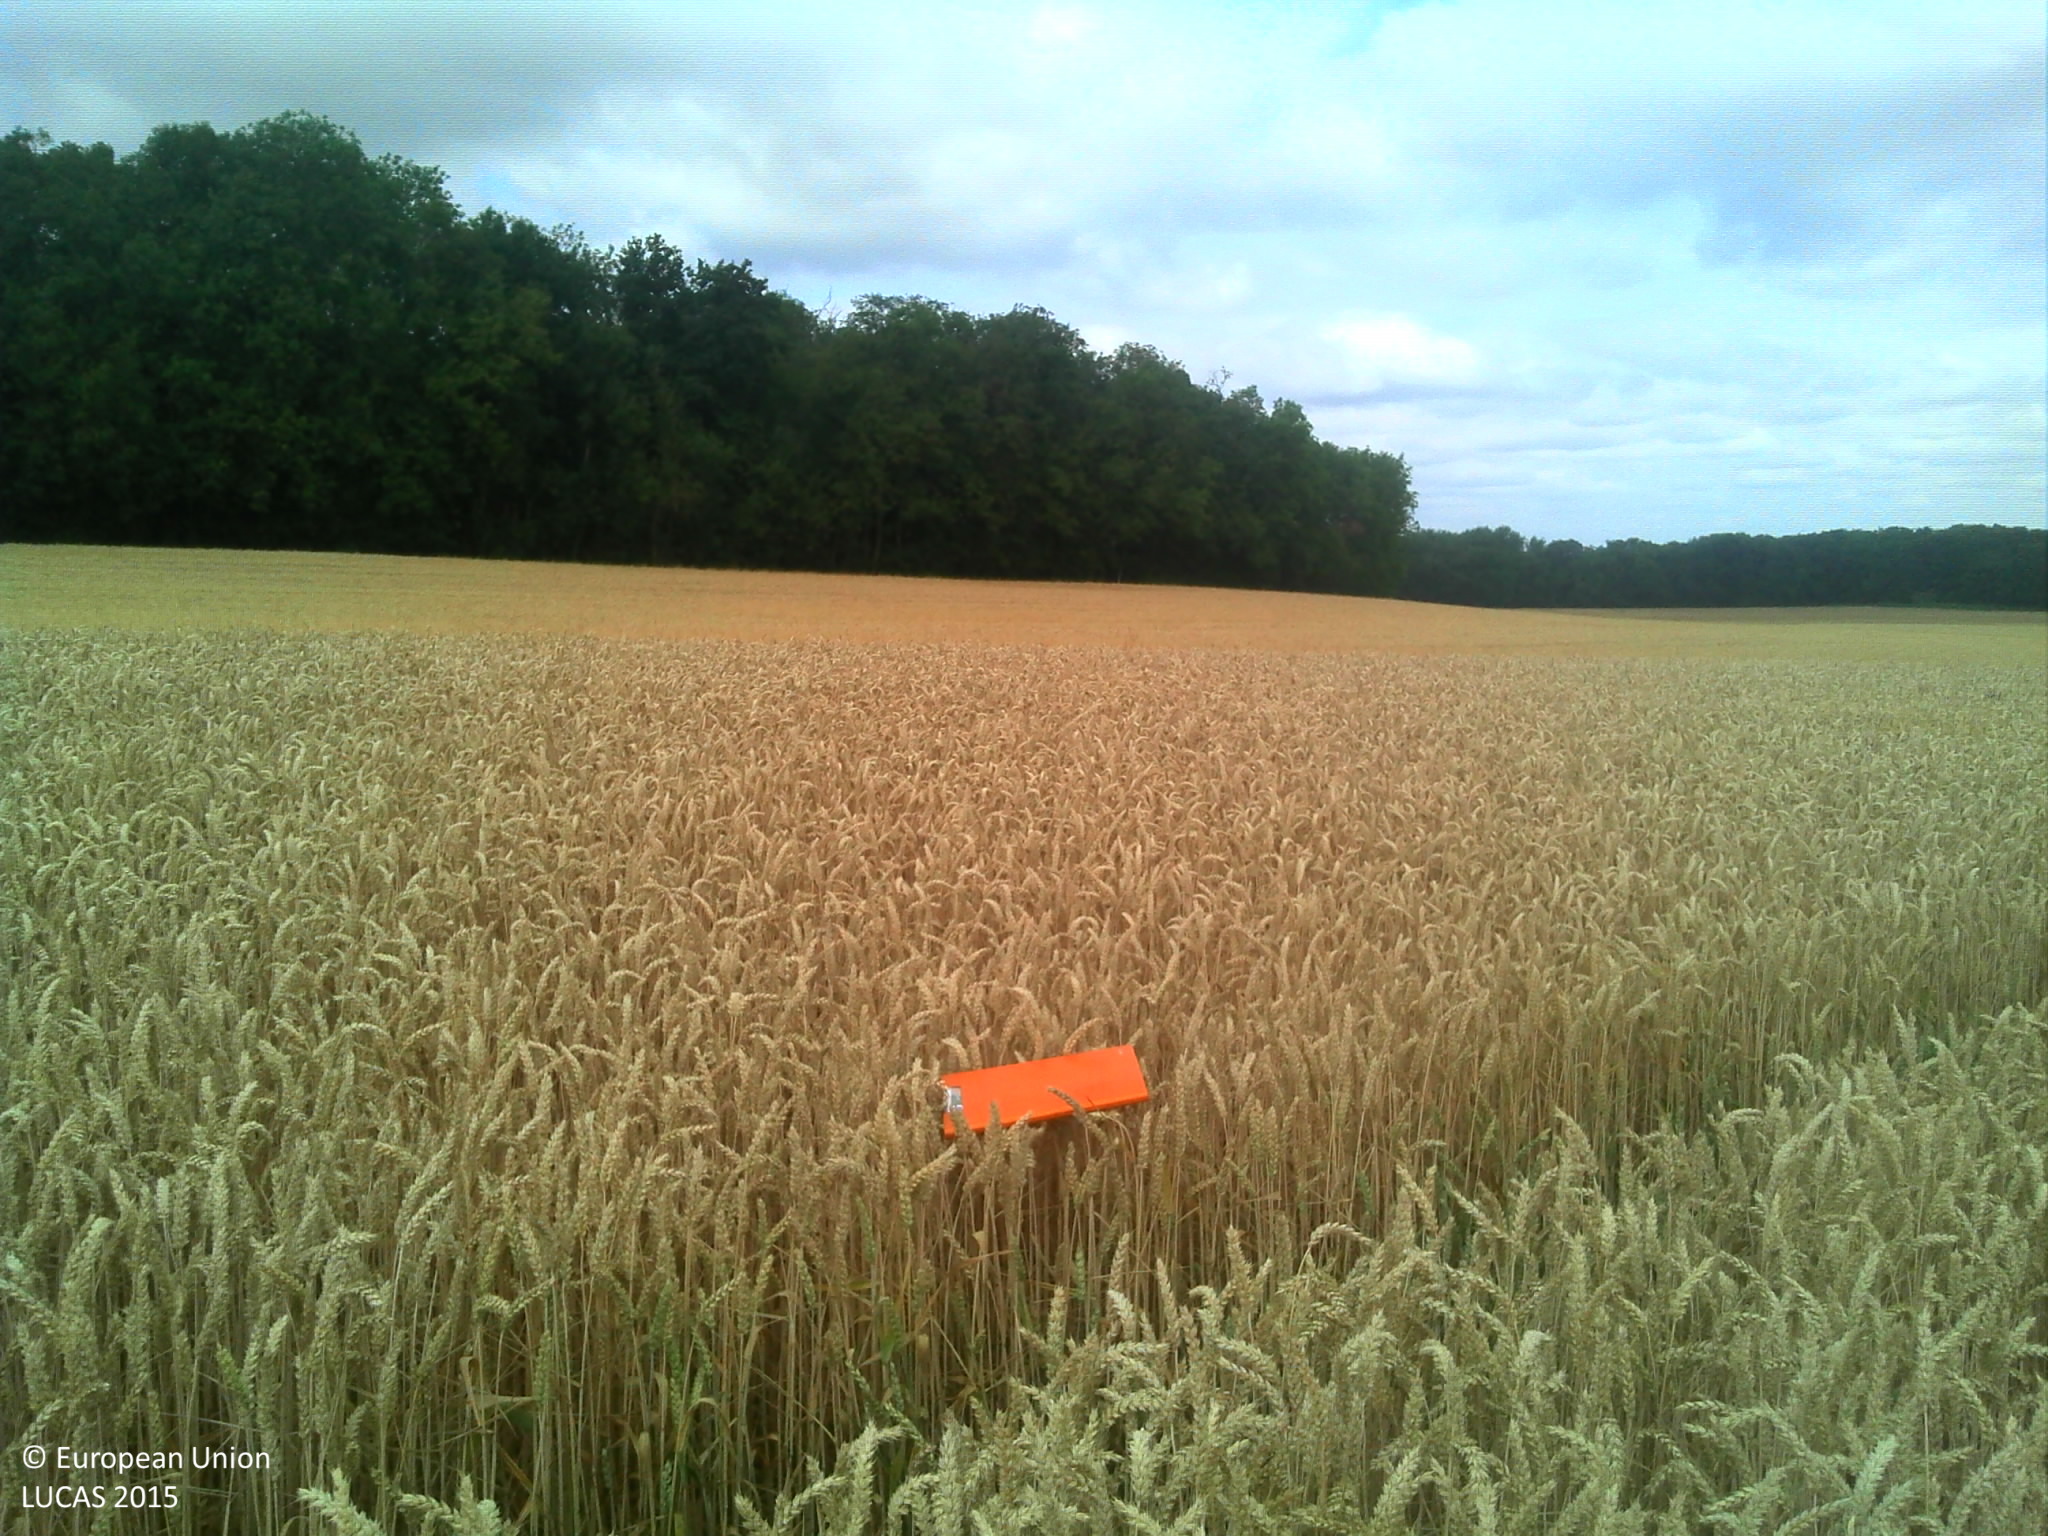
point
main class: Cropland
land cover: Common wheat
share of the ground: > 75 %
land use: Agriculture (excluding fallow land and kitchen gardens)
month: July
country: FR
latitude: 49.2636
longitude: 3.2724
